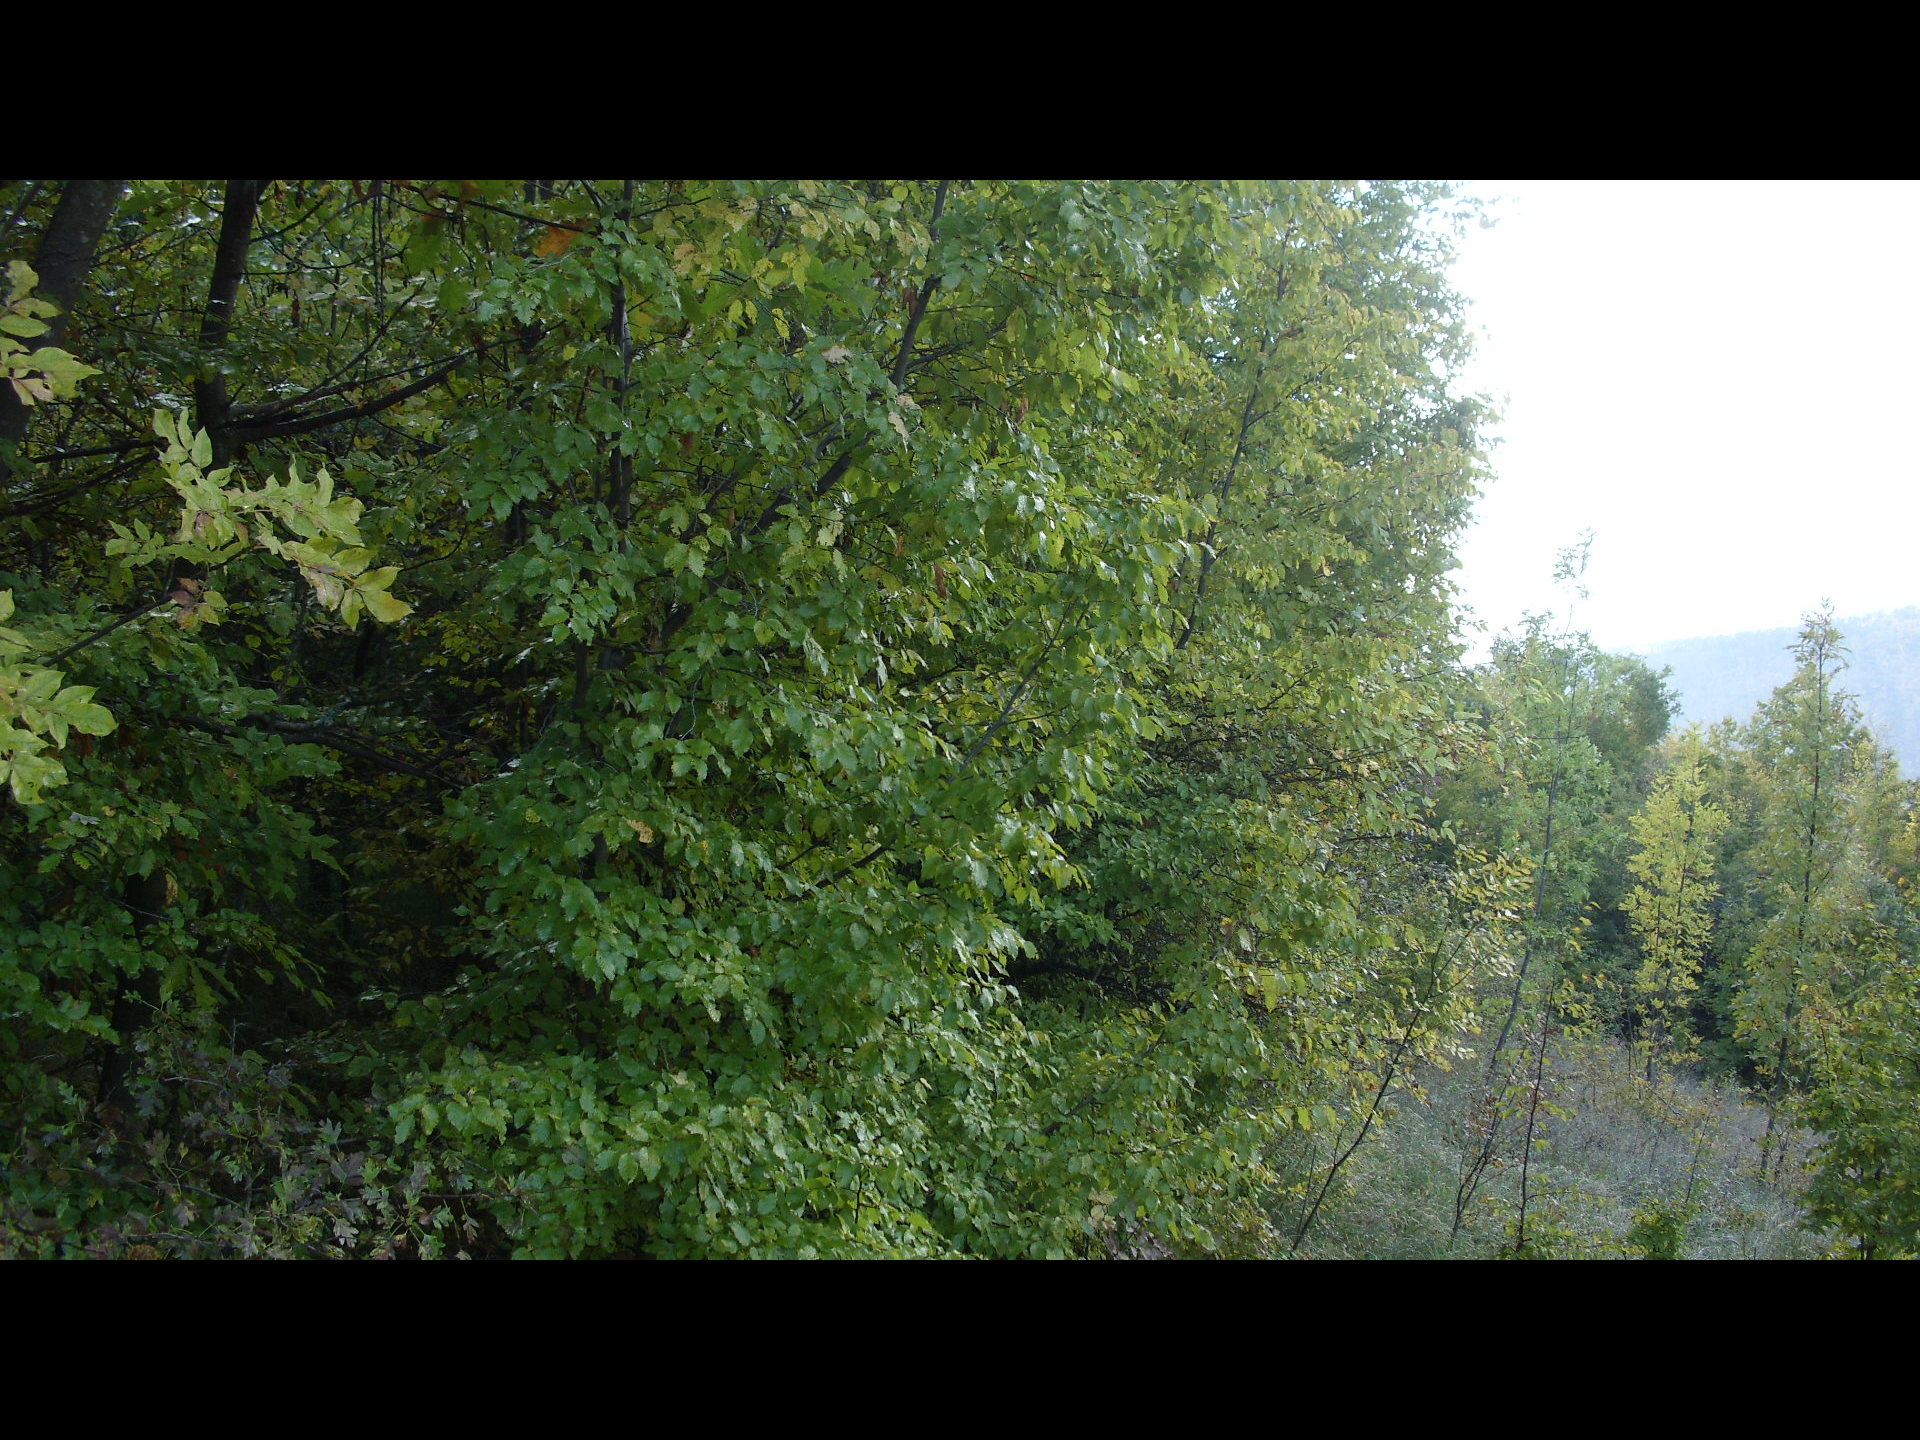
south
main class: Woodland
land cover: Broadleaved woodland
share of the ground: > 75 %
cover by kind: broadleaved forest trees 80 %, shrubs 10 %, herbaceous plants 10 %
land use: Forestry
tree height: < 5 m
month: October
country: BG
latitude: 43.6027
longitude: 22.5567
